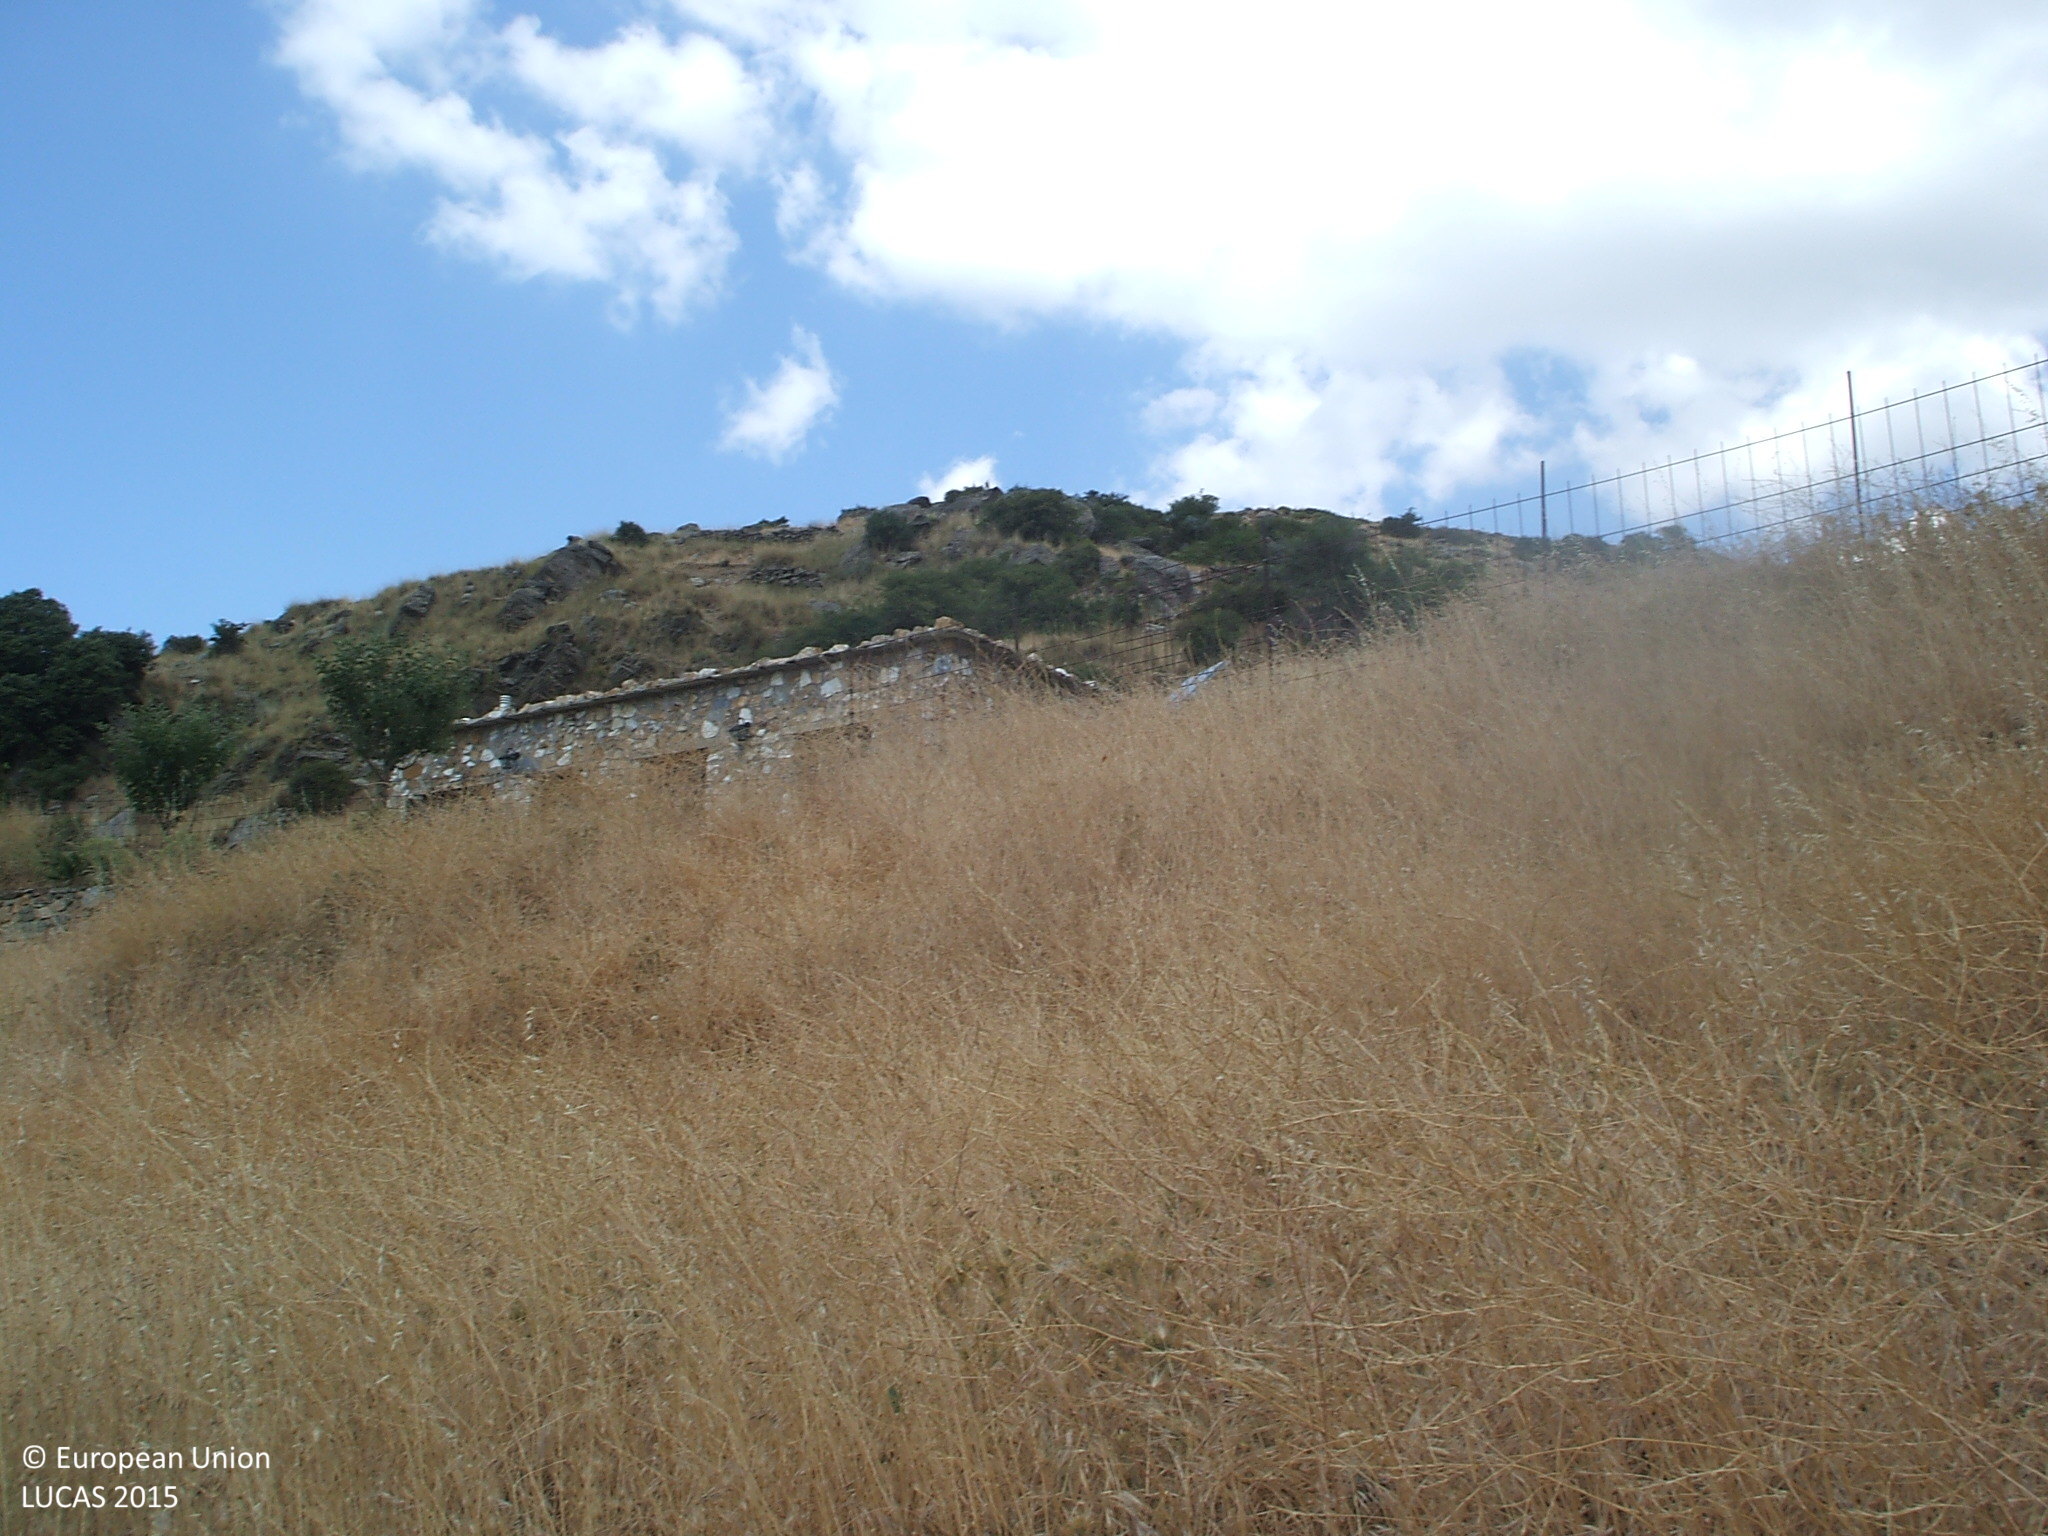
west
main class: Grassland
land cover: Grassland with sparse tree/shrub cover
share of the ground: > 75 %
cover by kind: herbaceous plants 95 %, broadleaved forest trees 5 %
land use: Semi-natural and natural areas not in use
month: July
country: ES
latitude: 37.0692
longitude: -2.8821
